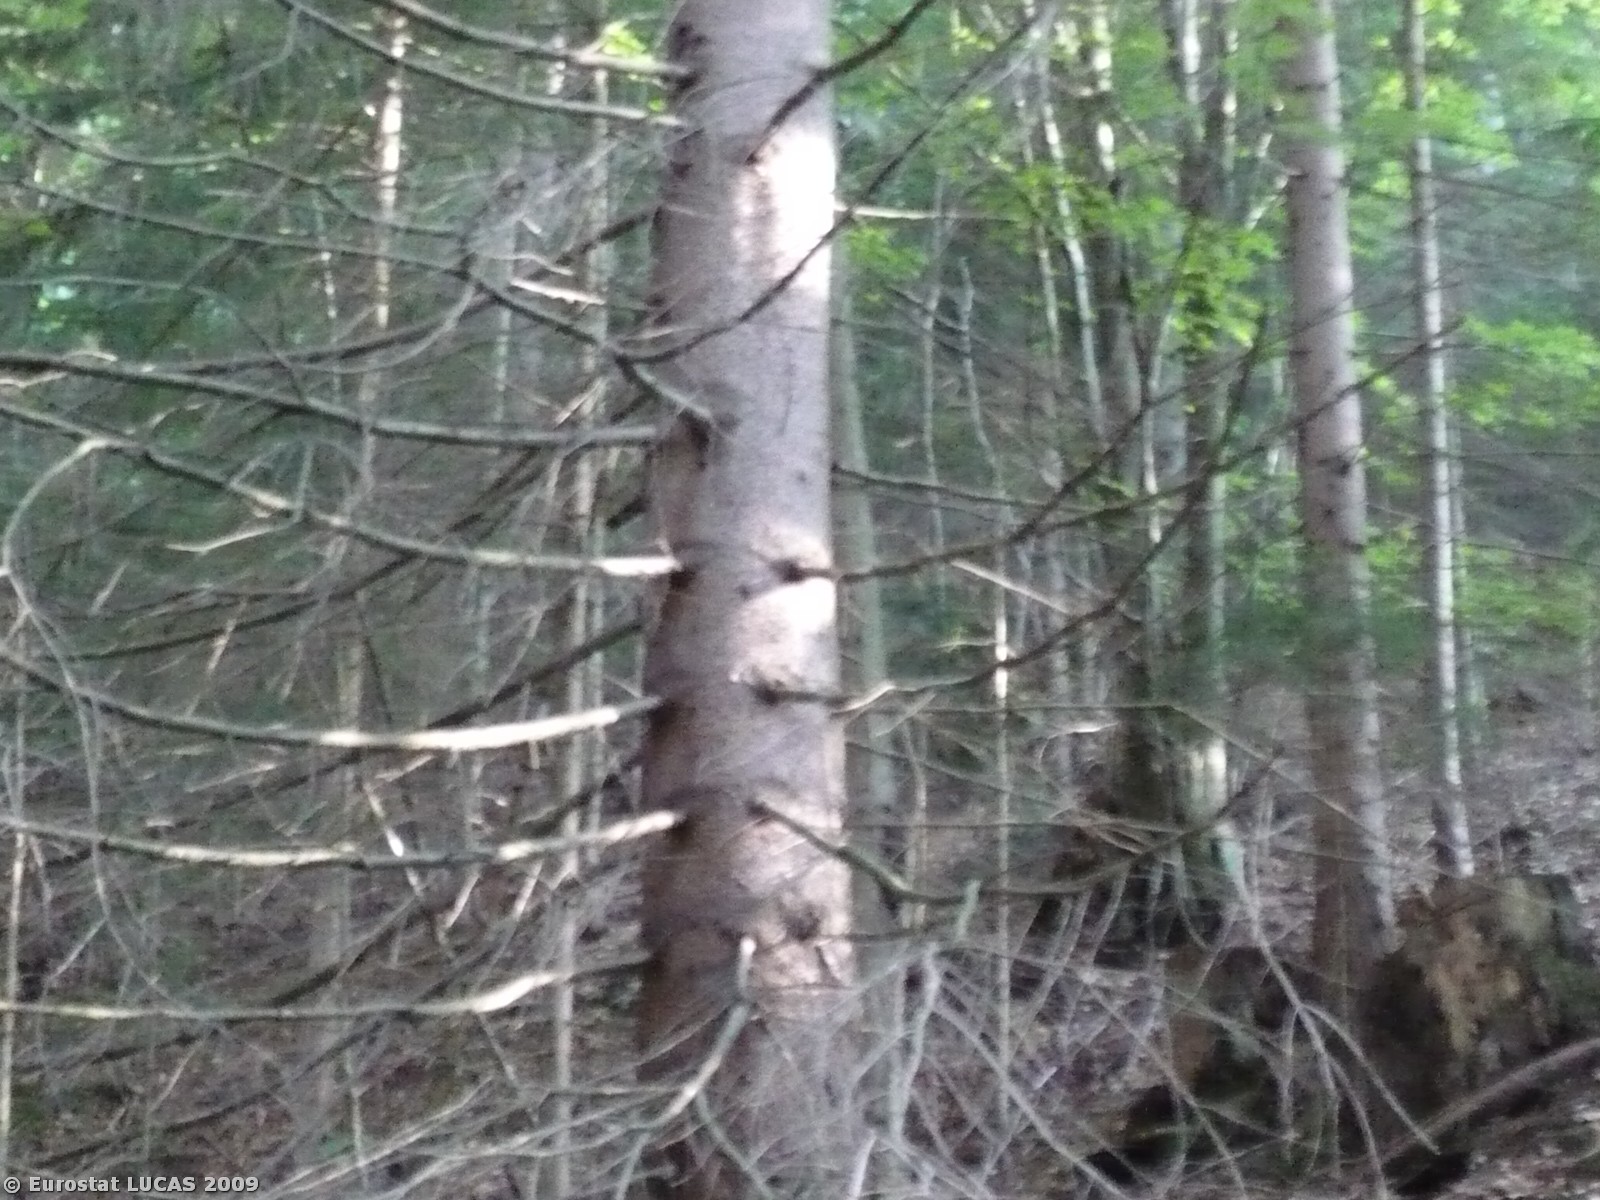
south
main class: Woodland
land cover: Coniferous woodland
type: alpine coniferous forest
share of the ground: > 75 %
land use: Forestry
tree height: > 5 m
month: June
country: SI
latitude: 46.4816
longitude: 13.8136
